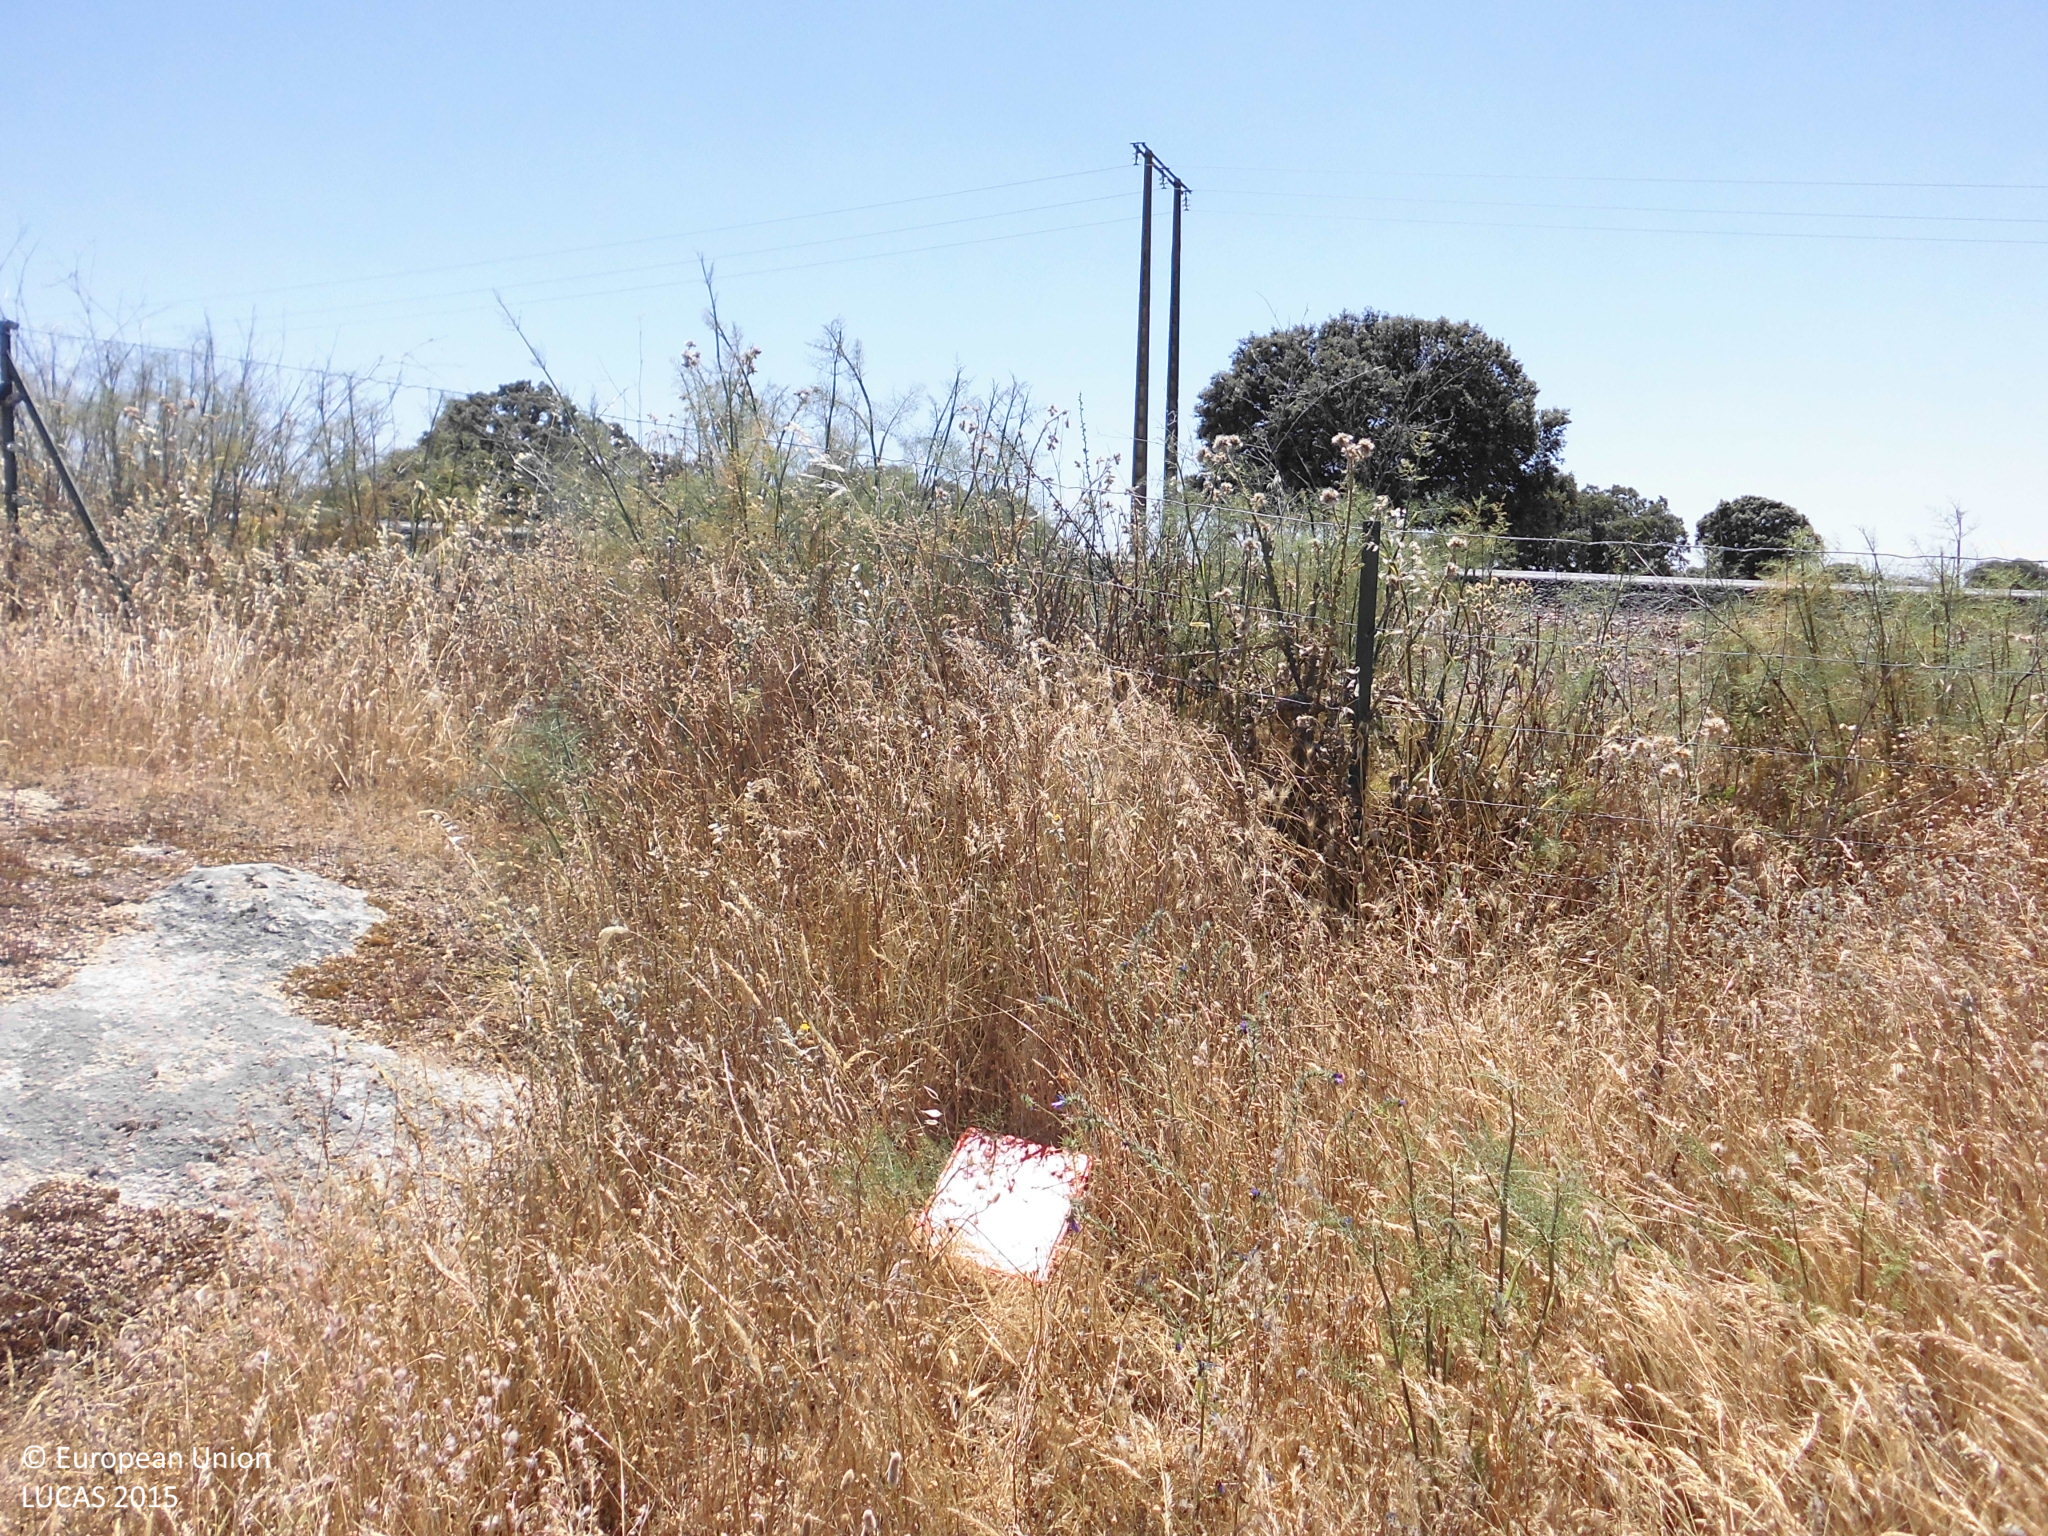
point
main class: Grassland
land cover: Grassland without tree/shrub cover
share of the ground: > 75 %
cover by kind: herbaceous plants 85 %, consolidated bare surface 10 %, shrubs 5 %
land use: Agriculture (excluding fallow land and kitchen gardens)
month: May
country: ES
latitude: 39.5408
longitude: -6.6084
